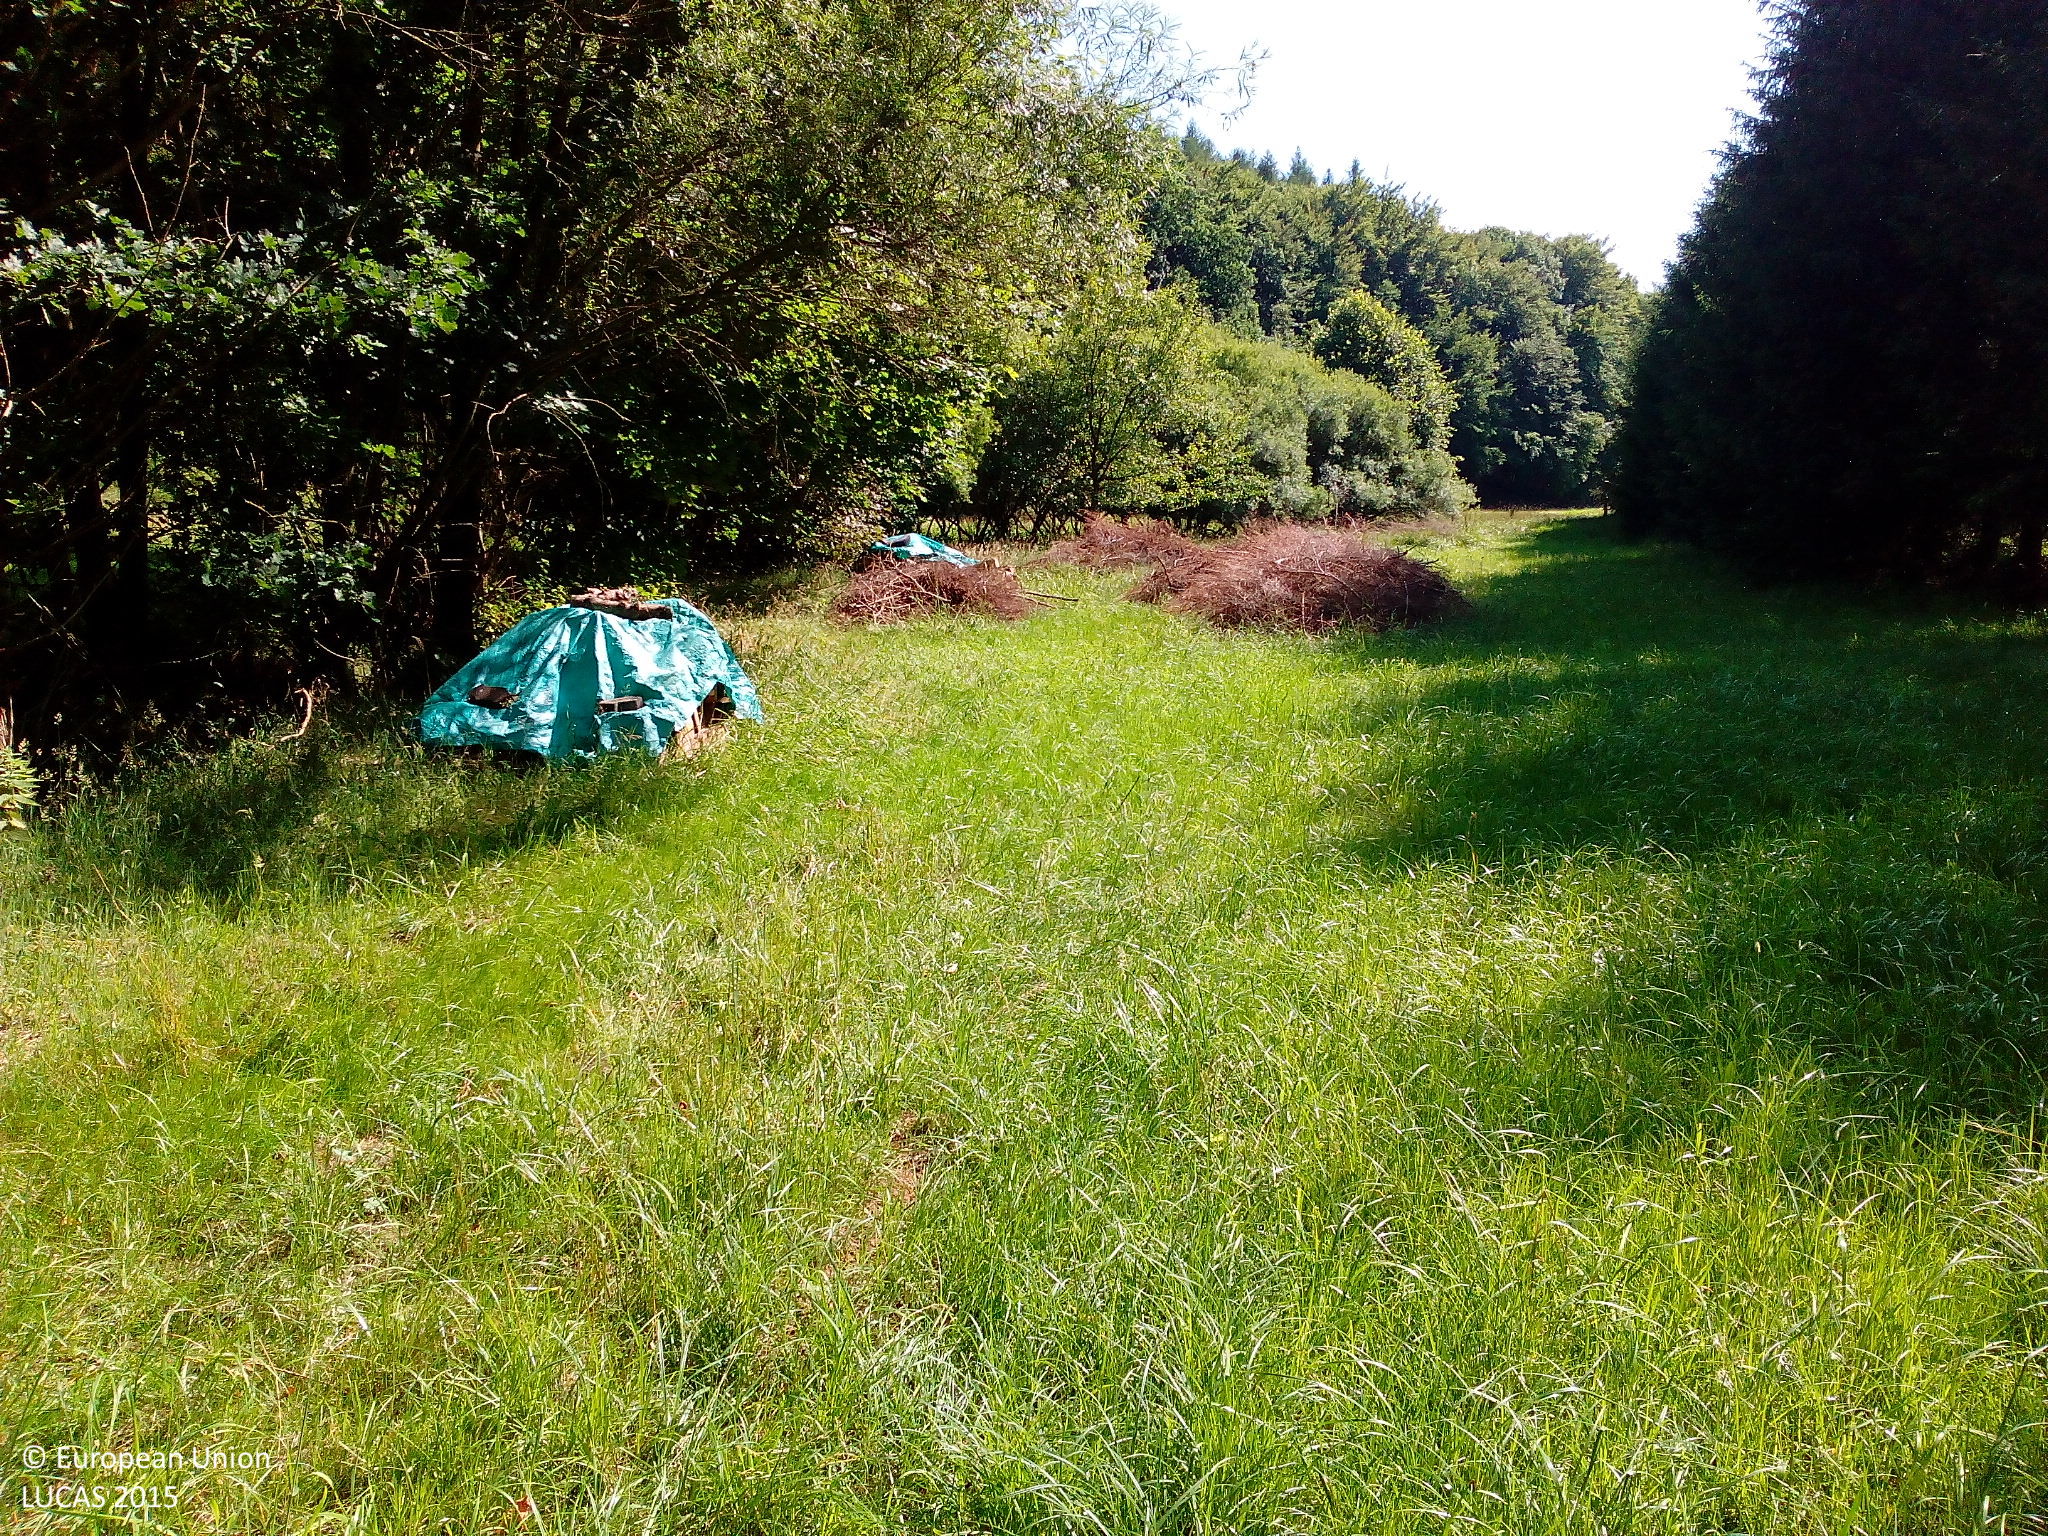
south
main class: Grassland
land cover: Grassland without tree/shrub cover
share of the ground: > 75 %
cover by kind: herbaceous plants 100 %
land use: Agriculture (excluding fallow land and kitchen gardens)
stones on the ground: < 10 %
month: July
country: DE
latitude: 50.9393
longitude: 9.8720
